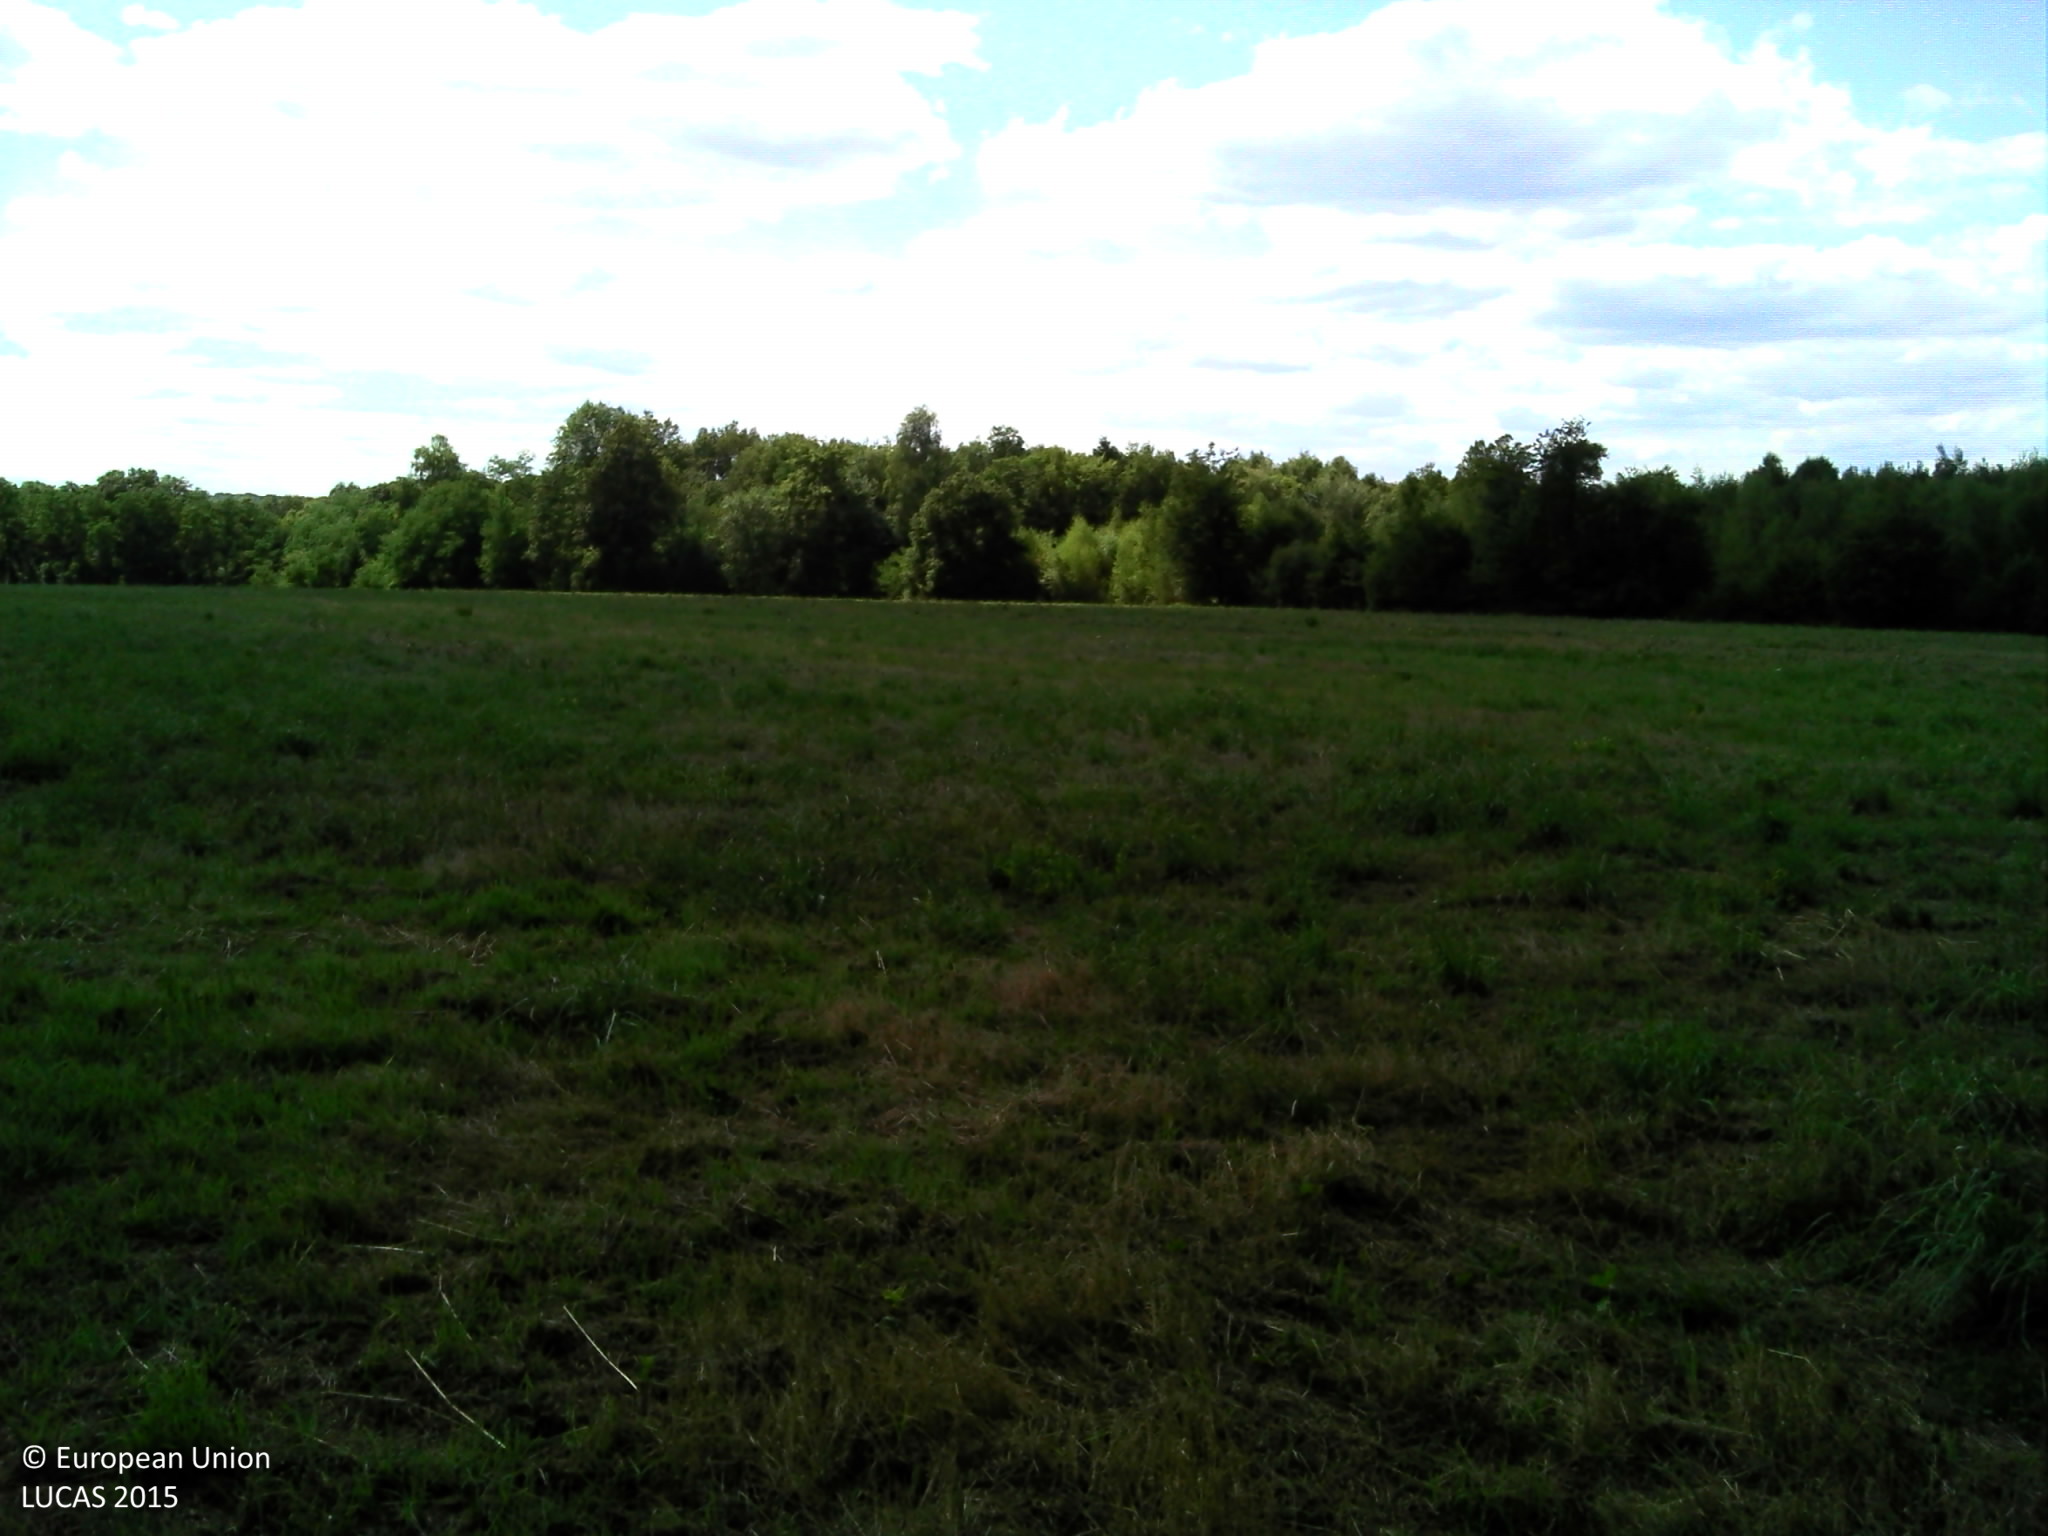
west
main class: Grassland
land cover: Spontaneously vegetated surfaces
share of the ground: > 75 %
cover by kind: herbaceous plants 100 %
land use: Fallow land
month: July
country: FR
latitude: 47.5785
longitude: 3.1744
